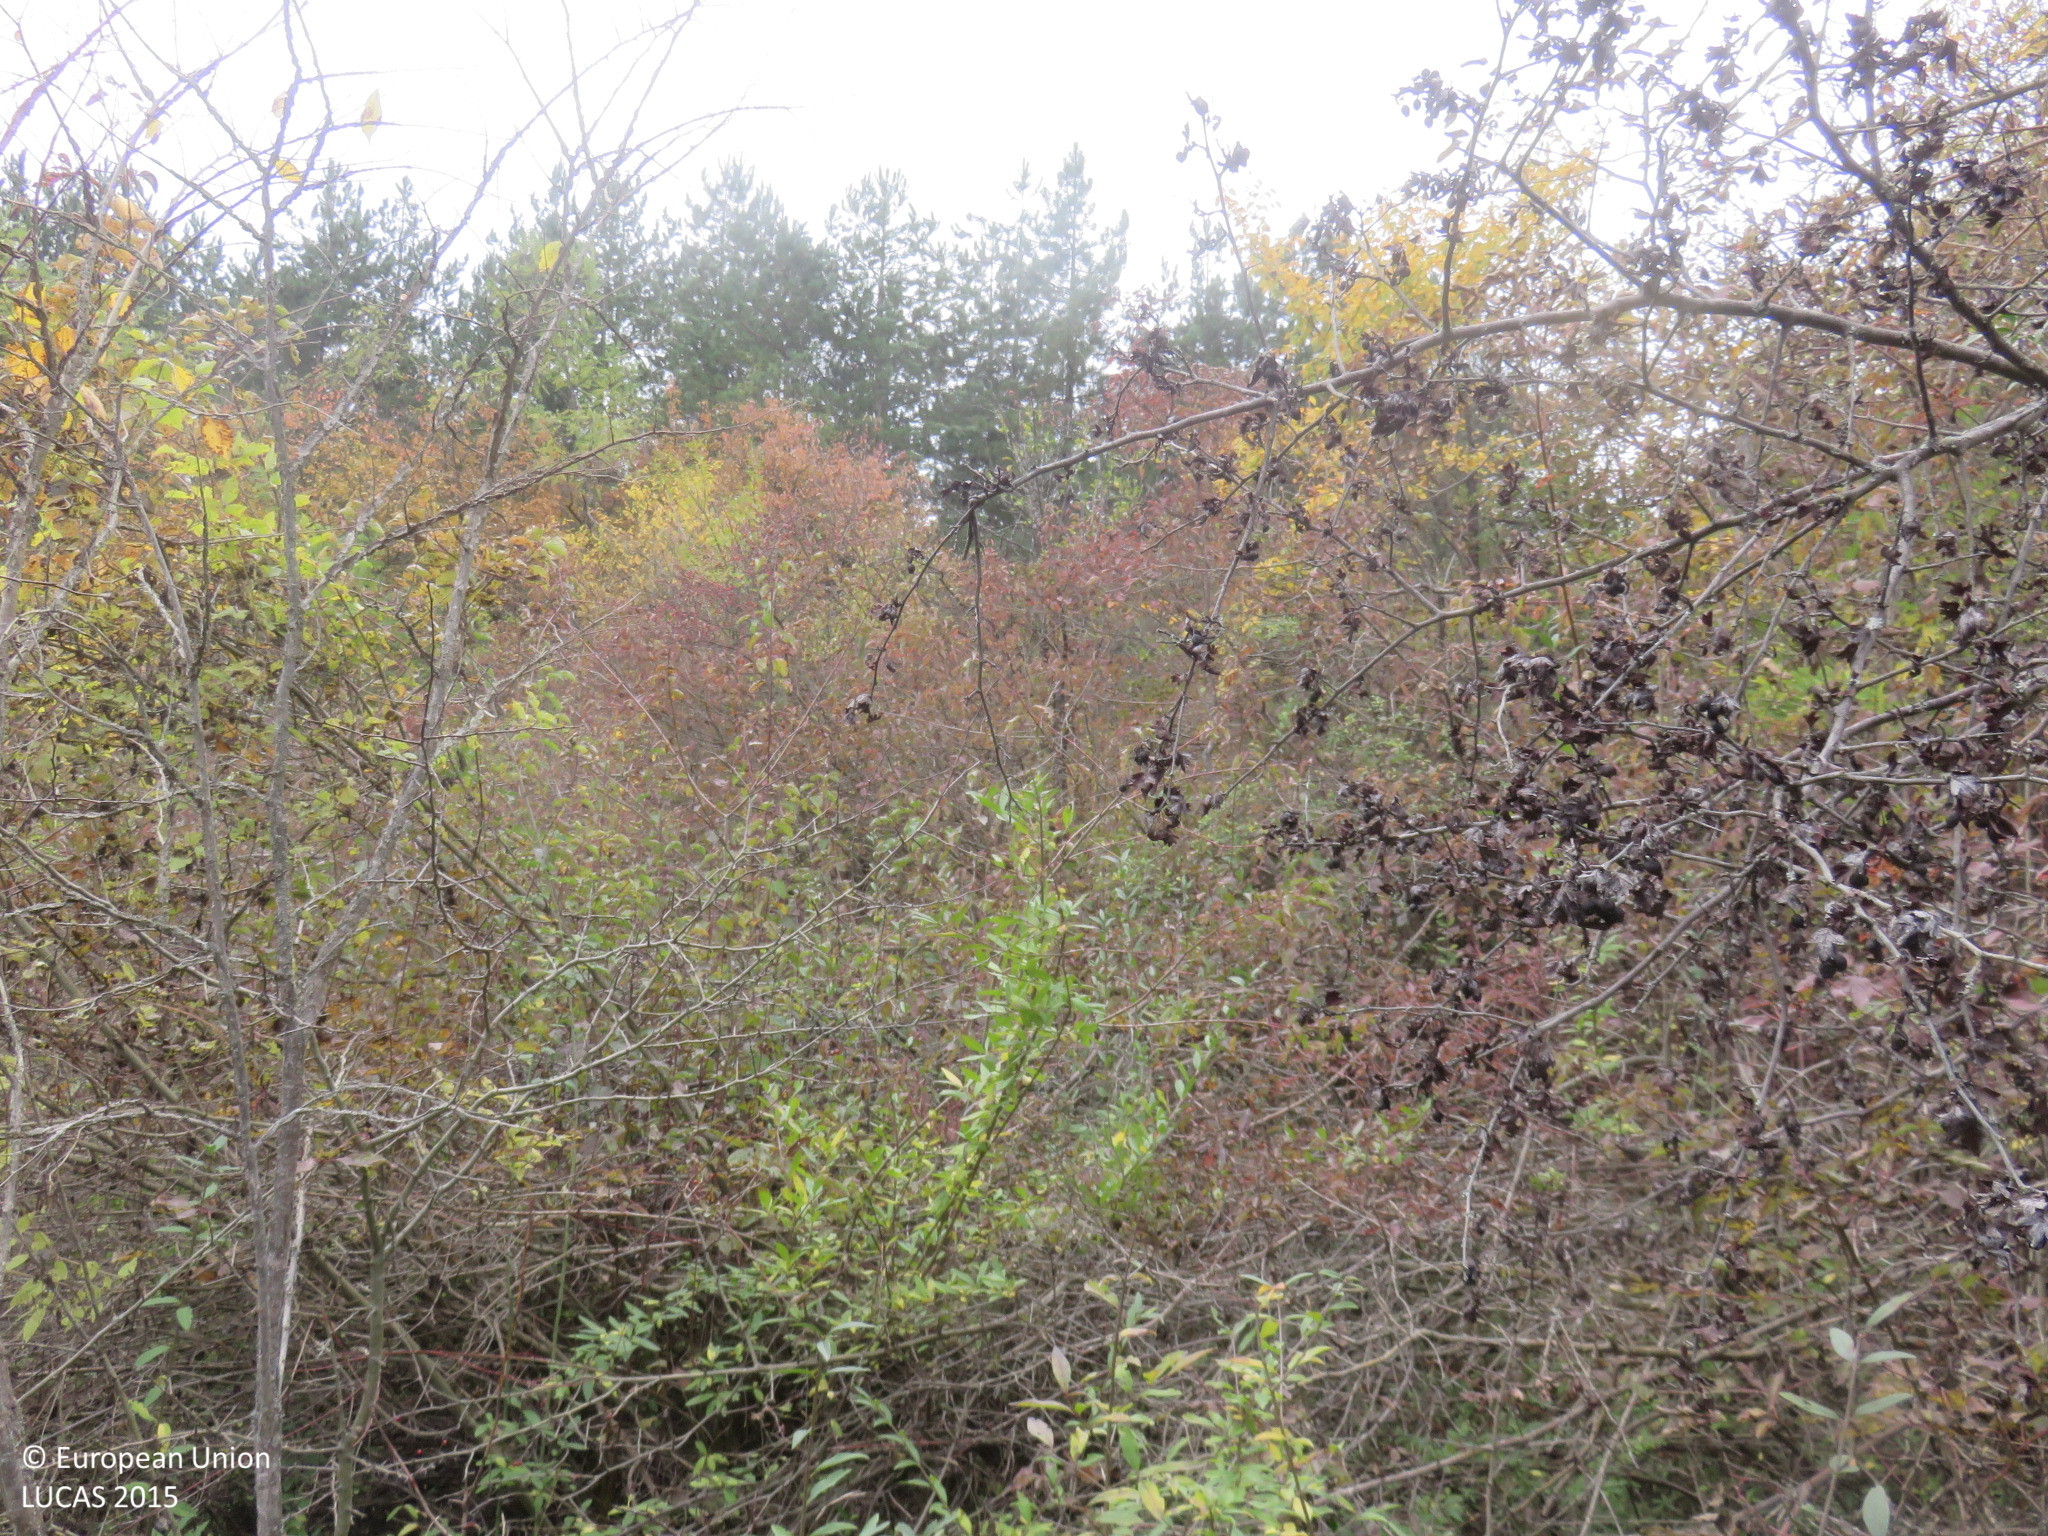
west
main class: Shrubland
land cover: Shrubland with sparse tree cover
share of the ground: > 75 %
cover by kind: shrubs 85 %, herbaceous plants 10 %, broadleaved forest trees 5 %
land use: Semi-natural and natural areas not in use
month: October
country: BG
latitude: 42.9973
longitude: 24.9936
